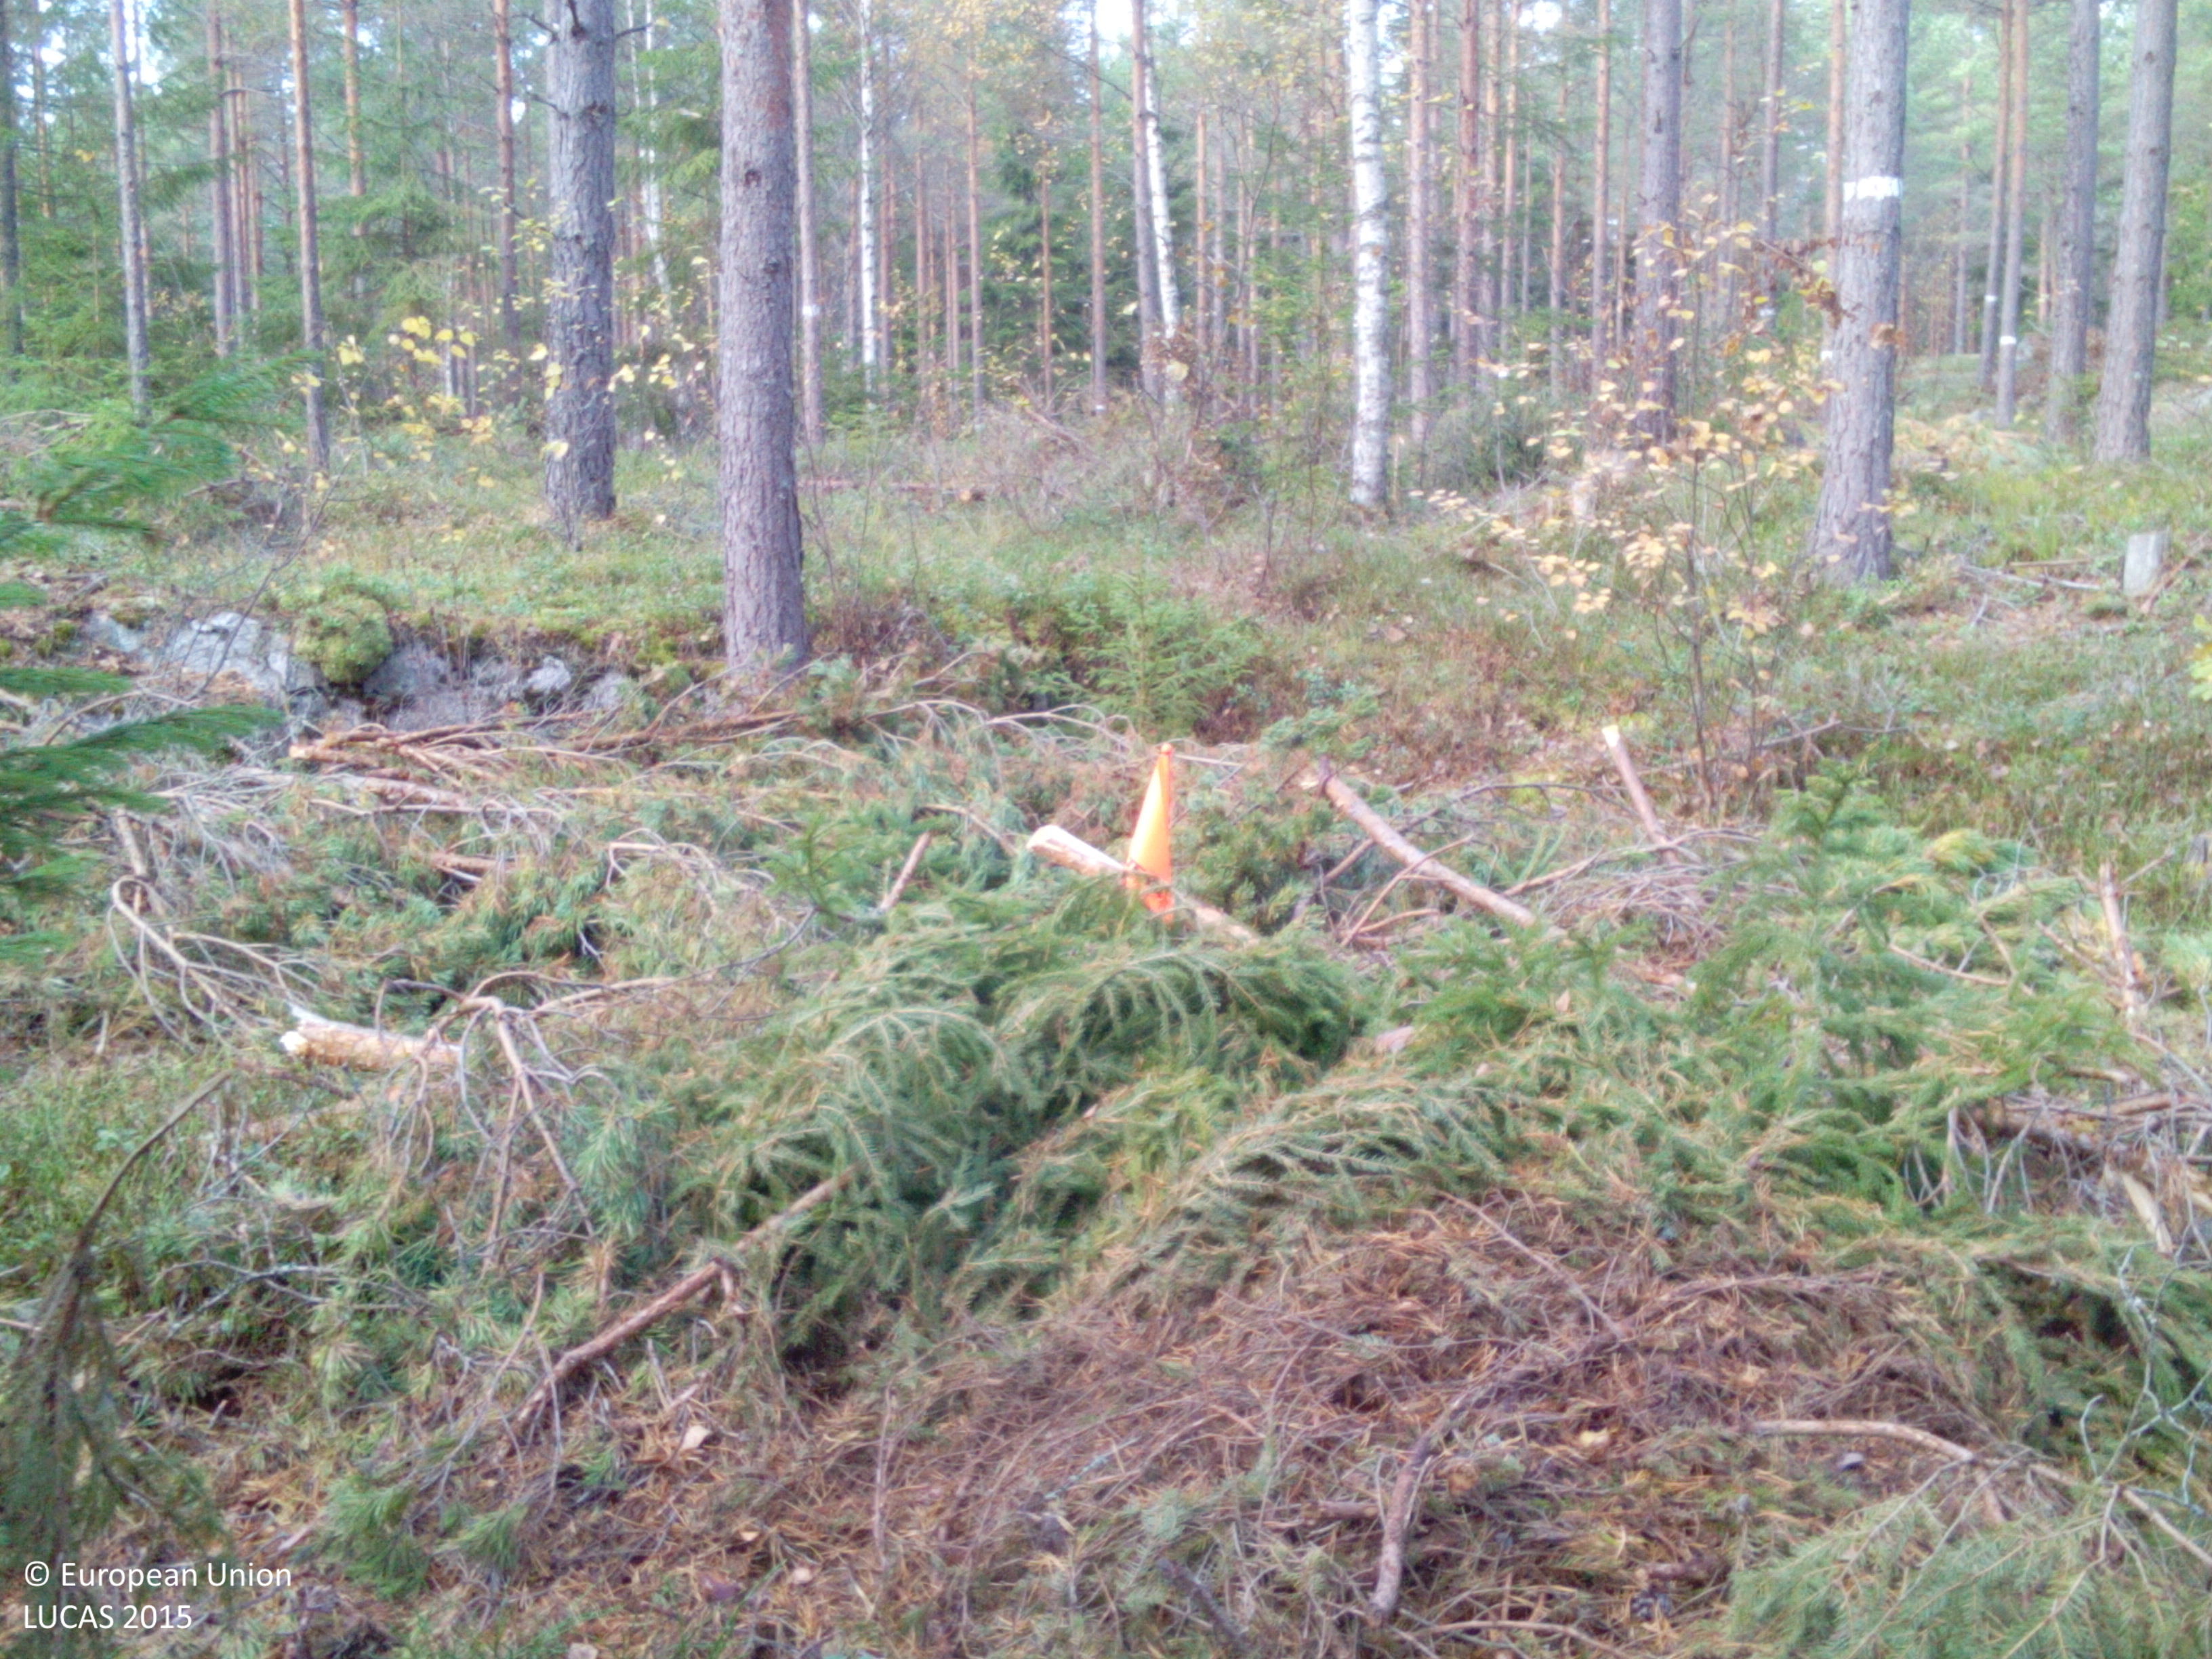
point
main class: Woodland
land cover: Pine dominated coniferous woodland
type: boreal forest
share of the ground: > 75 %
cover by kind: coniferous forest trees 80 %, lichens and mosses 10 %, broadleaved forest trees 5 %, herbaceous plants 5 %
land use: Forestry
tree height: > 5 m
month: October
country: SE
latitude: 58.9935
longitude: 16.2768
